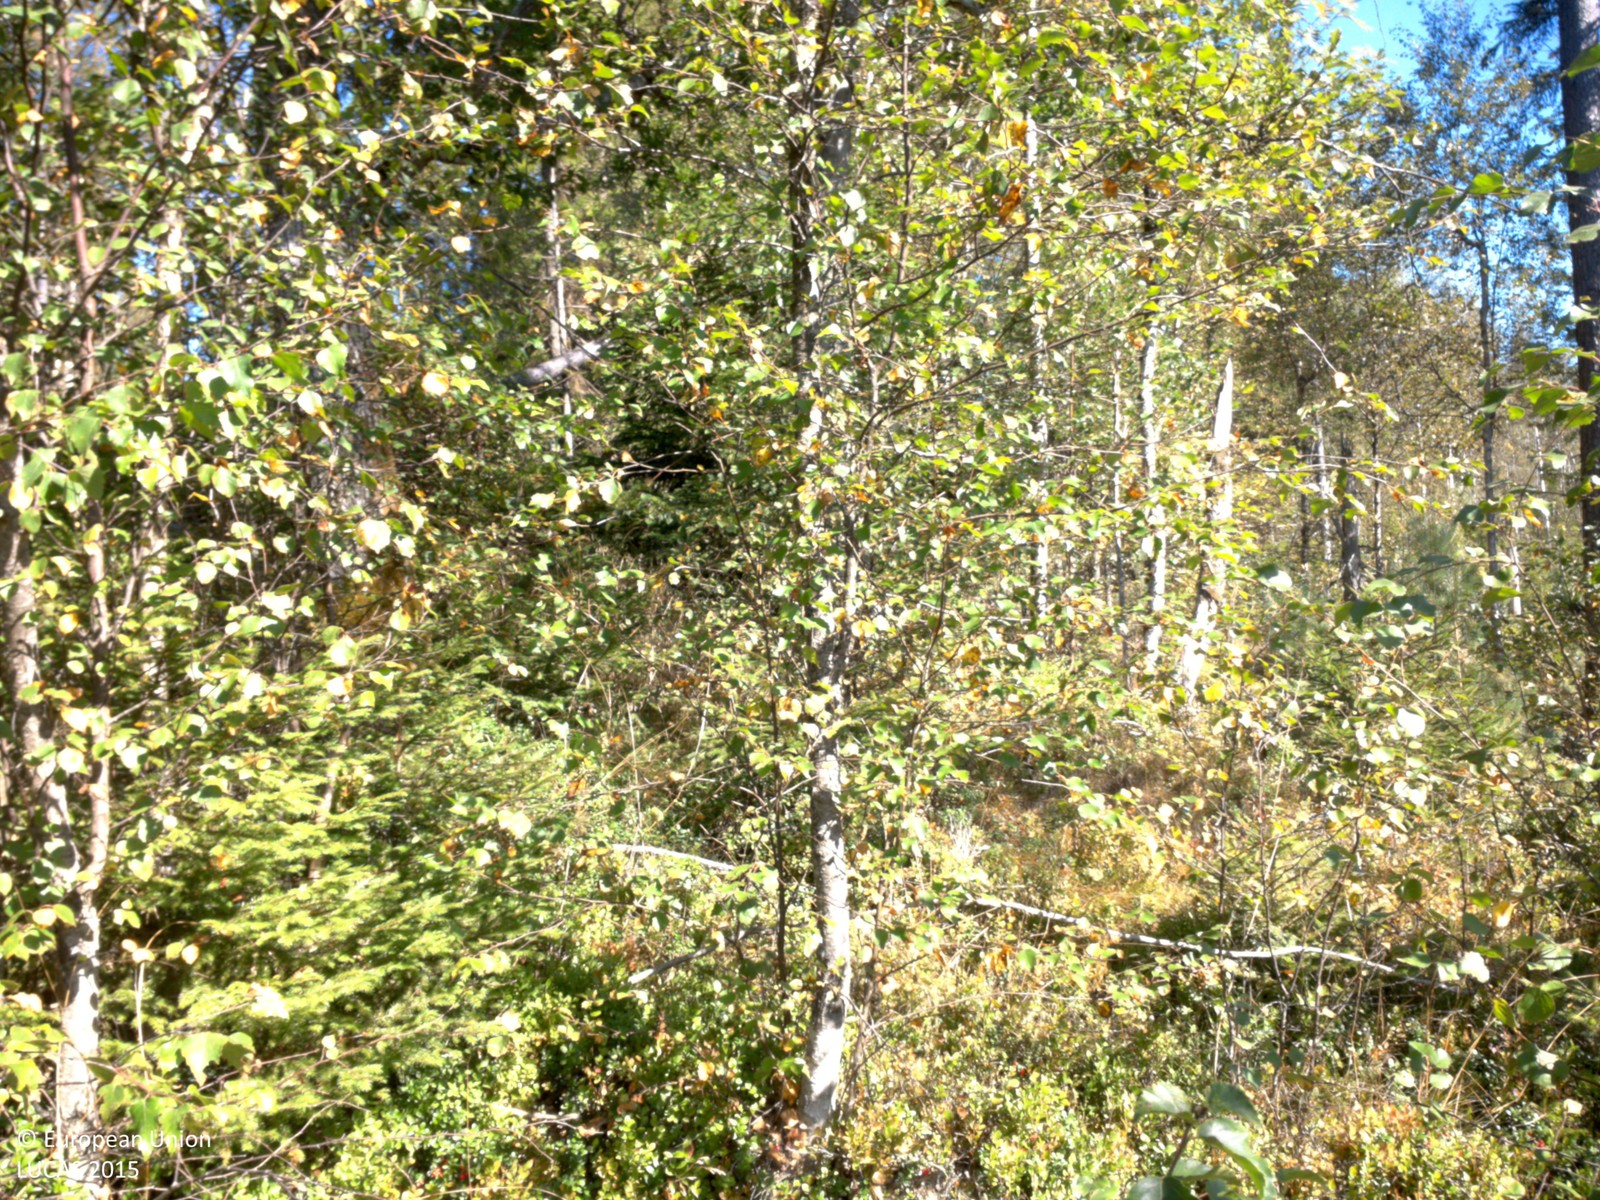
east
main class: Woodland
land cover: Pine dominated mixed woodland
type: boreal forest
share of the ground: 50 - 75 %
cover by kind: coniferous forest trees 50 %, herbaceous plants 30 %, broadleaved forest trees 20 %
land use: Forestry
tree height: > 5 m
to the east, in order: Pine dominated mixed woodland; Spruce dominated mixed woodland; Spruce dominated coniferous woodland
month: August
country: SE
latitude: 58.5284
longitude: 12.0051
